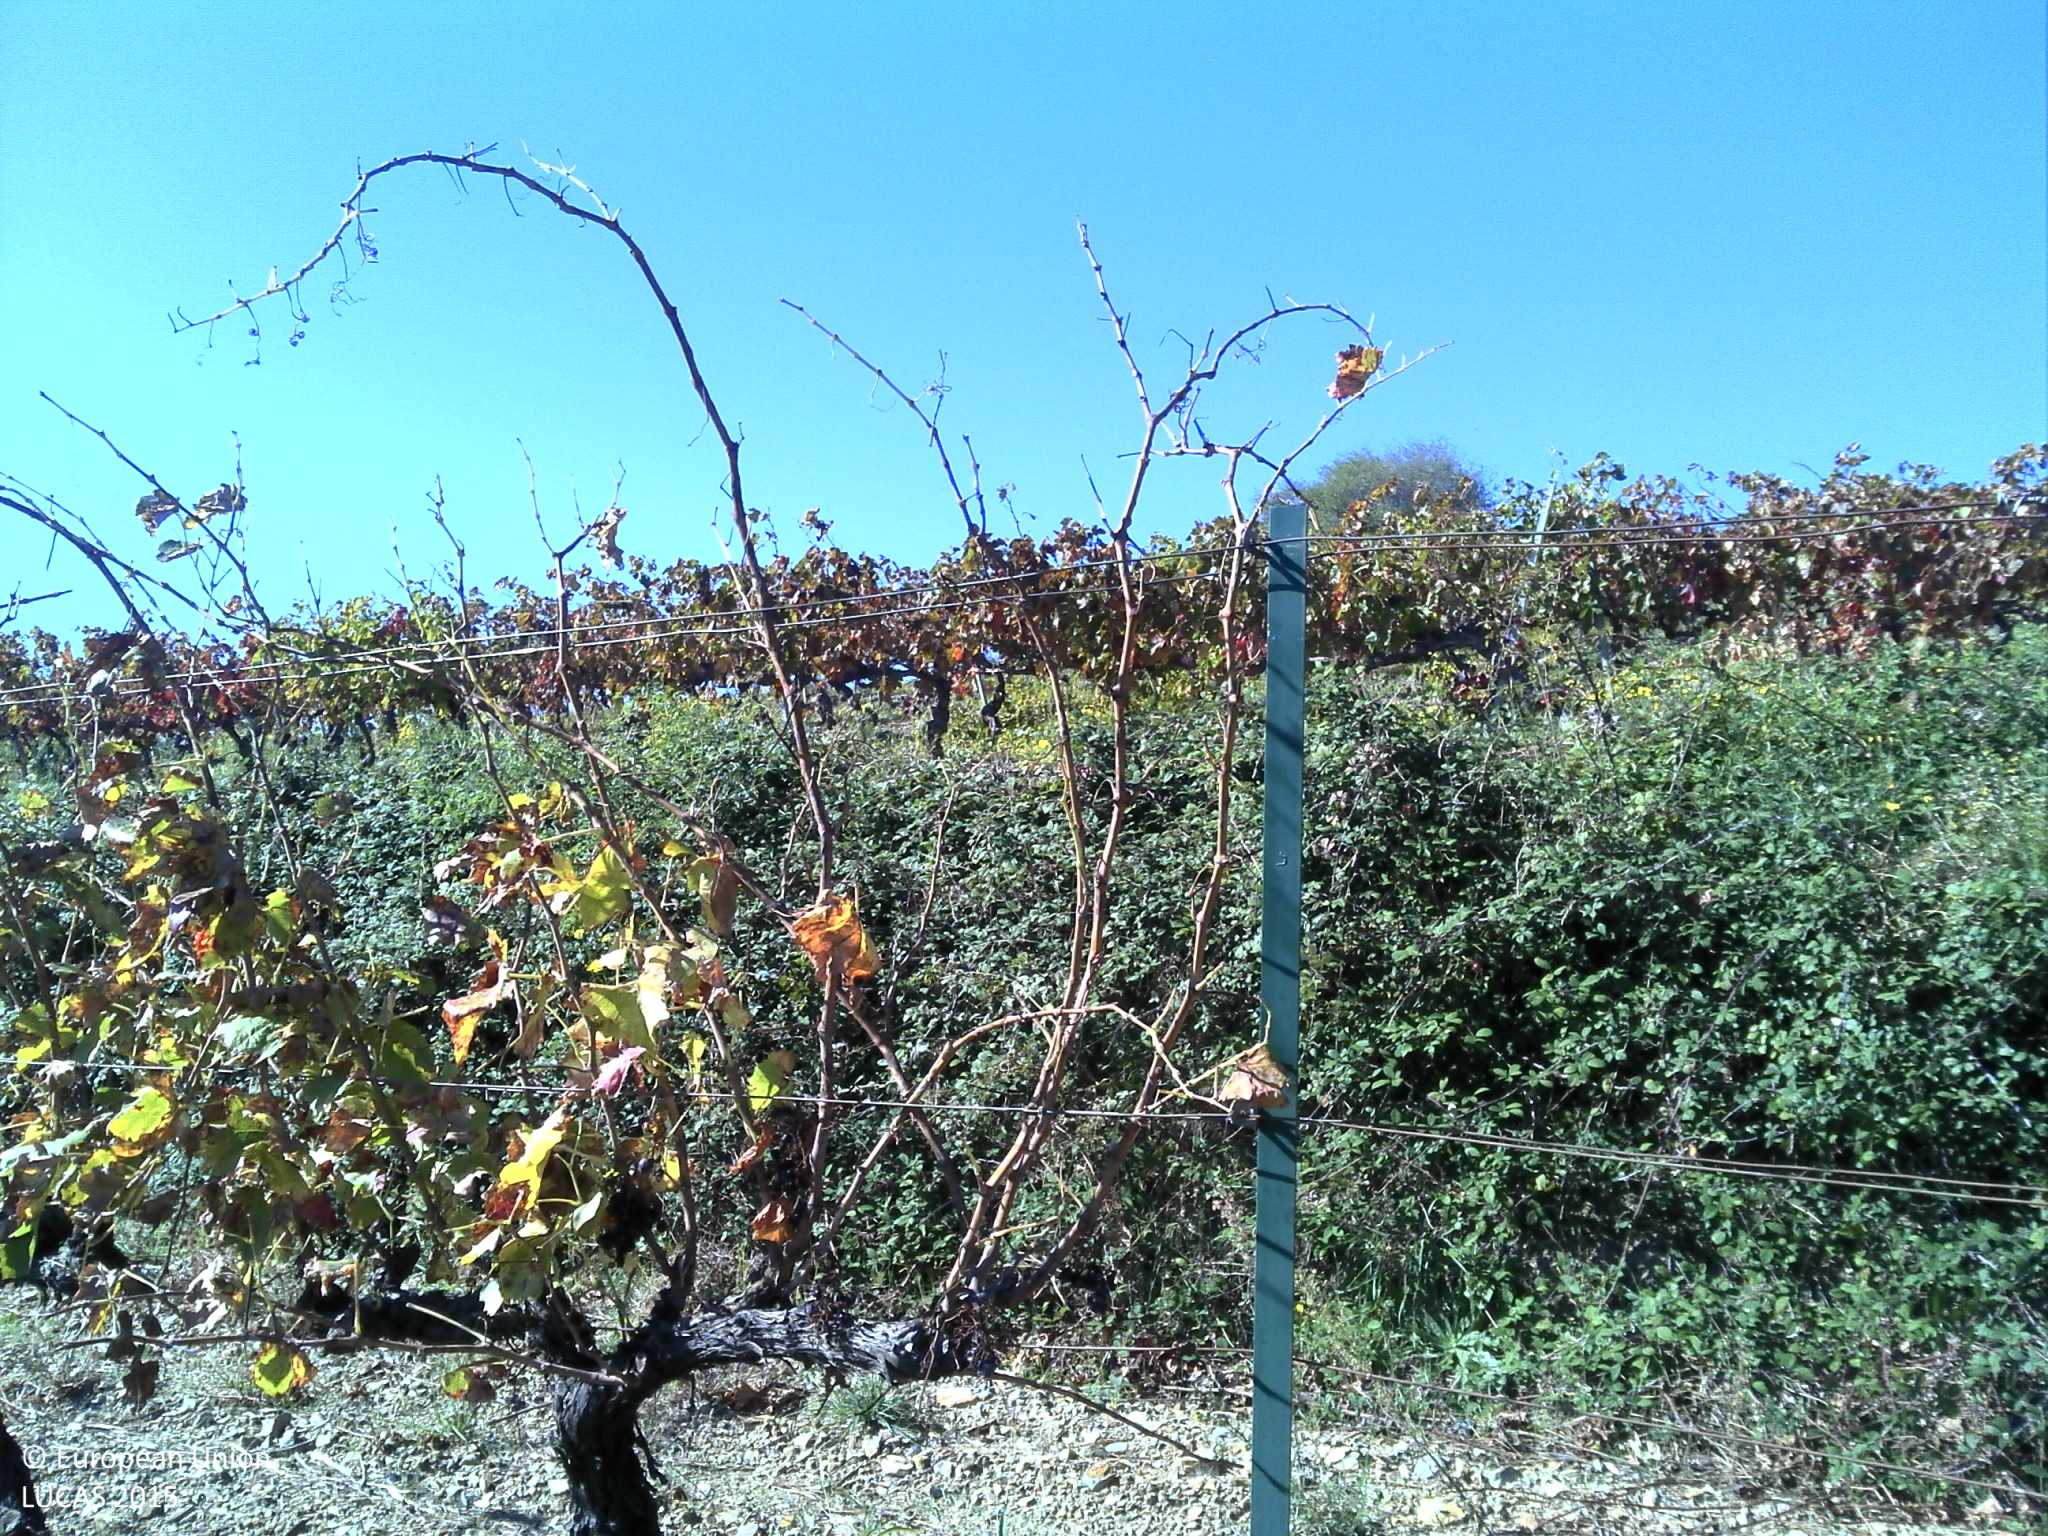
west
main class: Cropland
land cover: Vineyards
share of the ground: 10 - 25 %
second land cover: Spontaneously vegetated surfaces
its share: 50 - 75 %
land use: Agriculture (excluding fallow land and kitchen gardens)
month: October
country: FR
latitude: 43.5442
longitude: 3.1394
